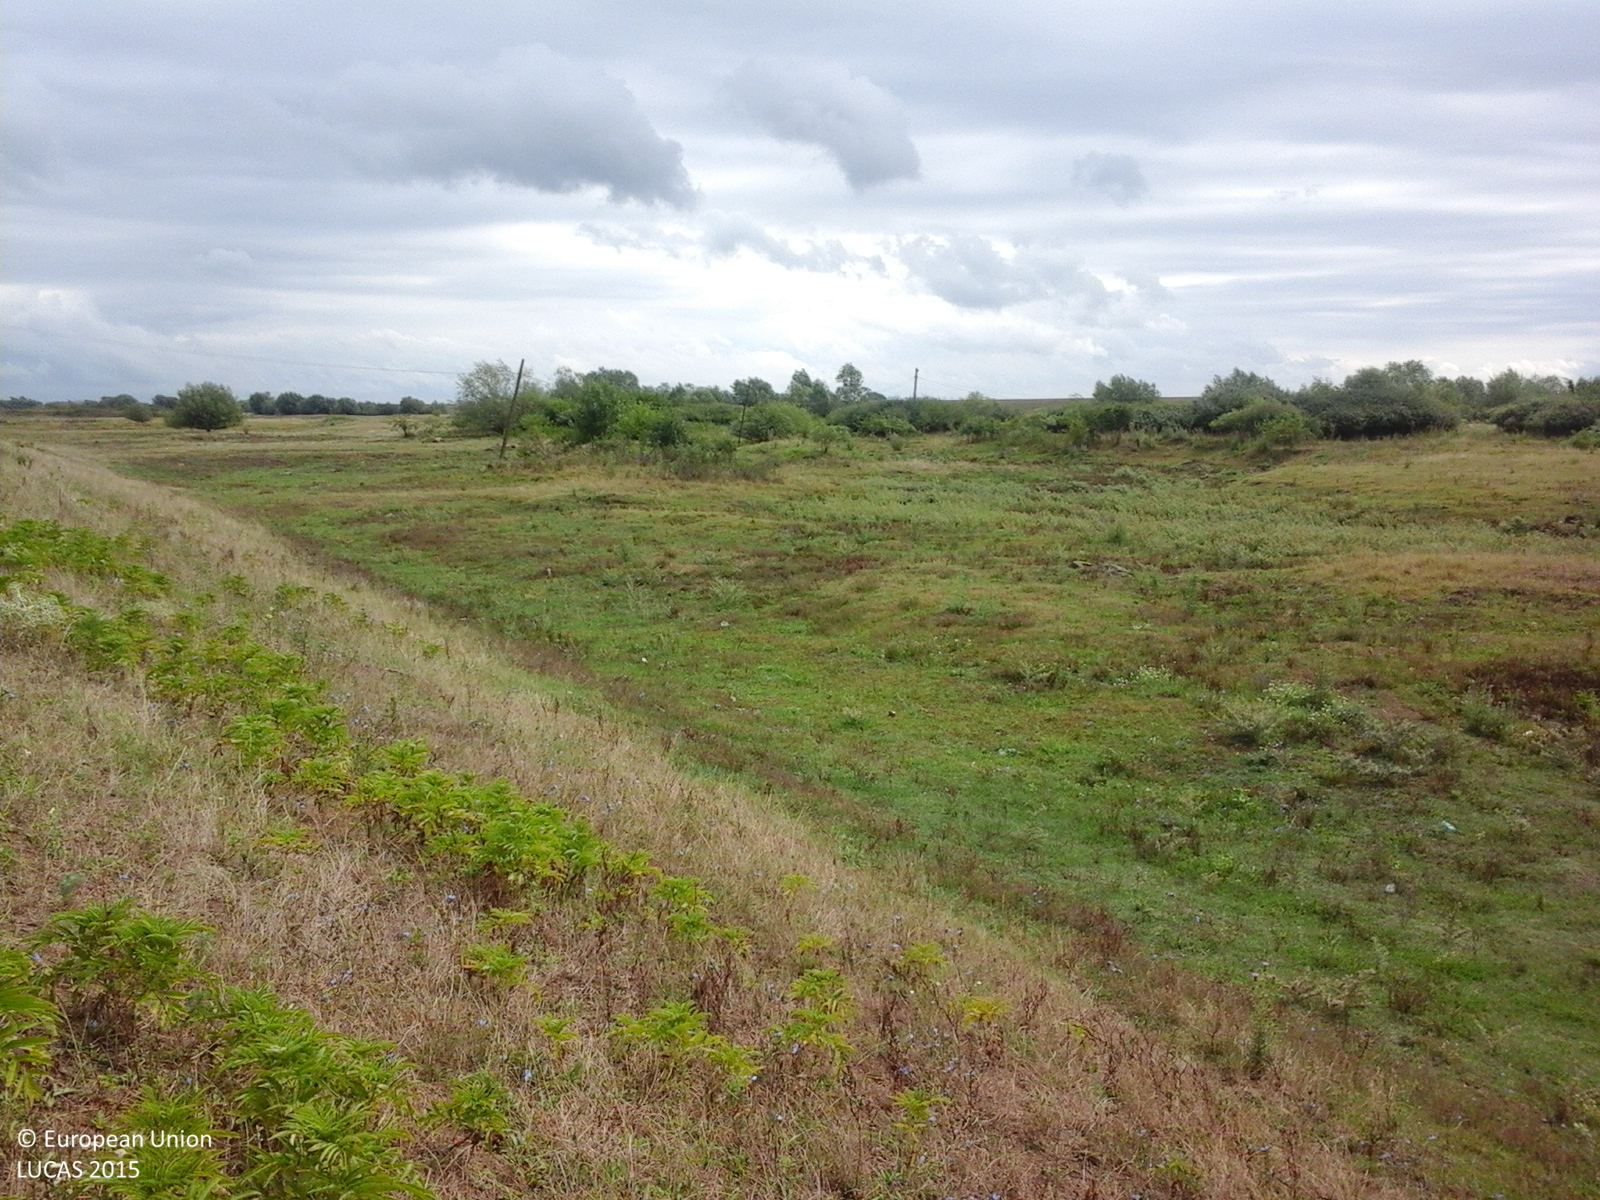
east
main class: Grassland
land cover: Grassland without tree/shrub cover
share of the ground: > 75 %
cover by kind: herbaceous plants 100 %
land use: Agriculture (excluding fallow land and kitchen gardens)
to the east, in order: Grassland without tree/shrub cover; Grassland with sparse tree/shrub cover; Electric lines; Grassland with sparse tree/shrub cover; Shrubland with sparse tree cover; Tracks; Grass margins; Broadleaved woodland; Inland fresh running water
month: August
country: RO
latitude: 45.5250
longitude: 21.0251
